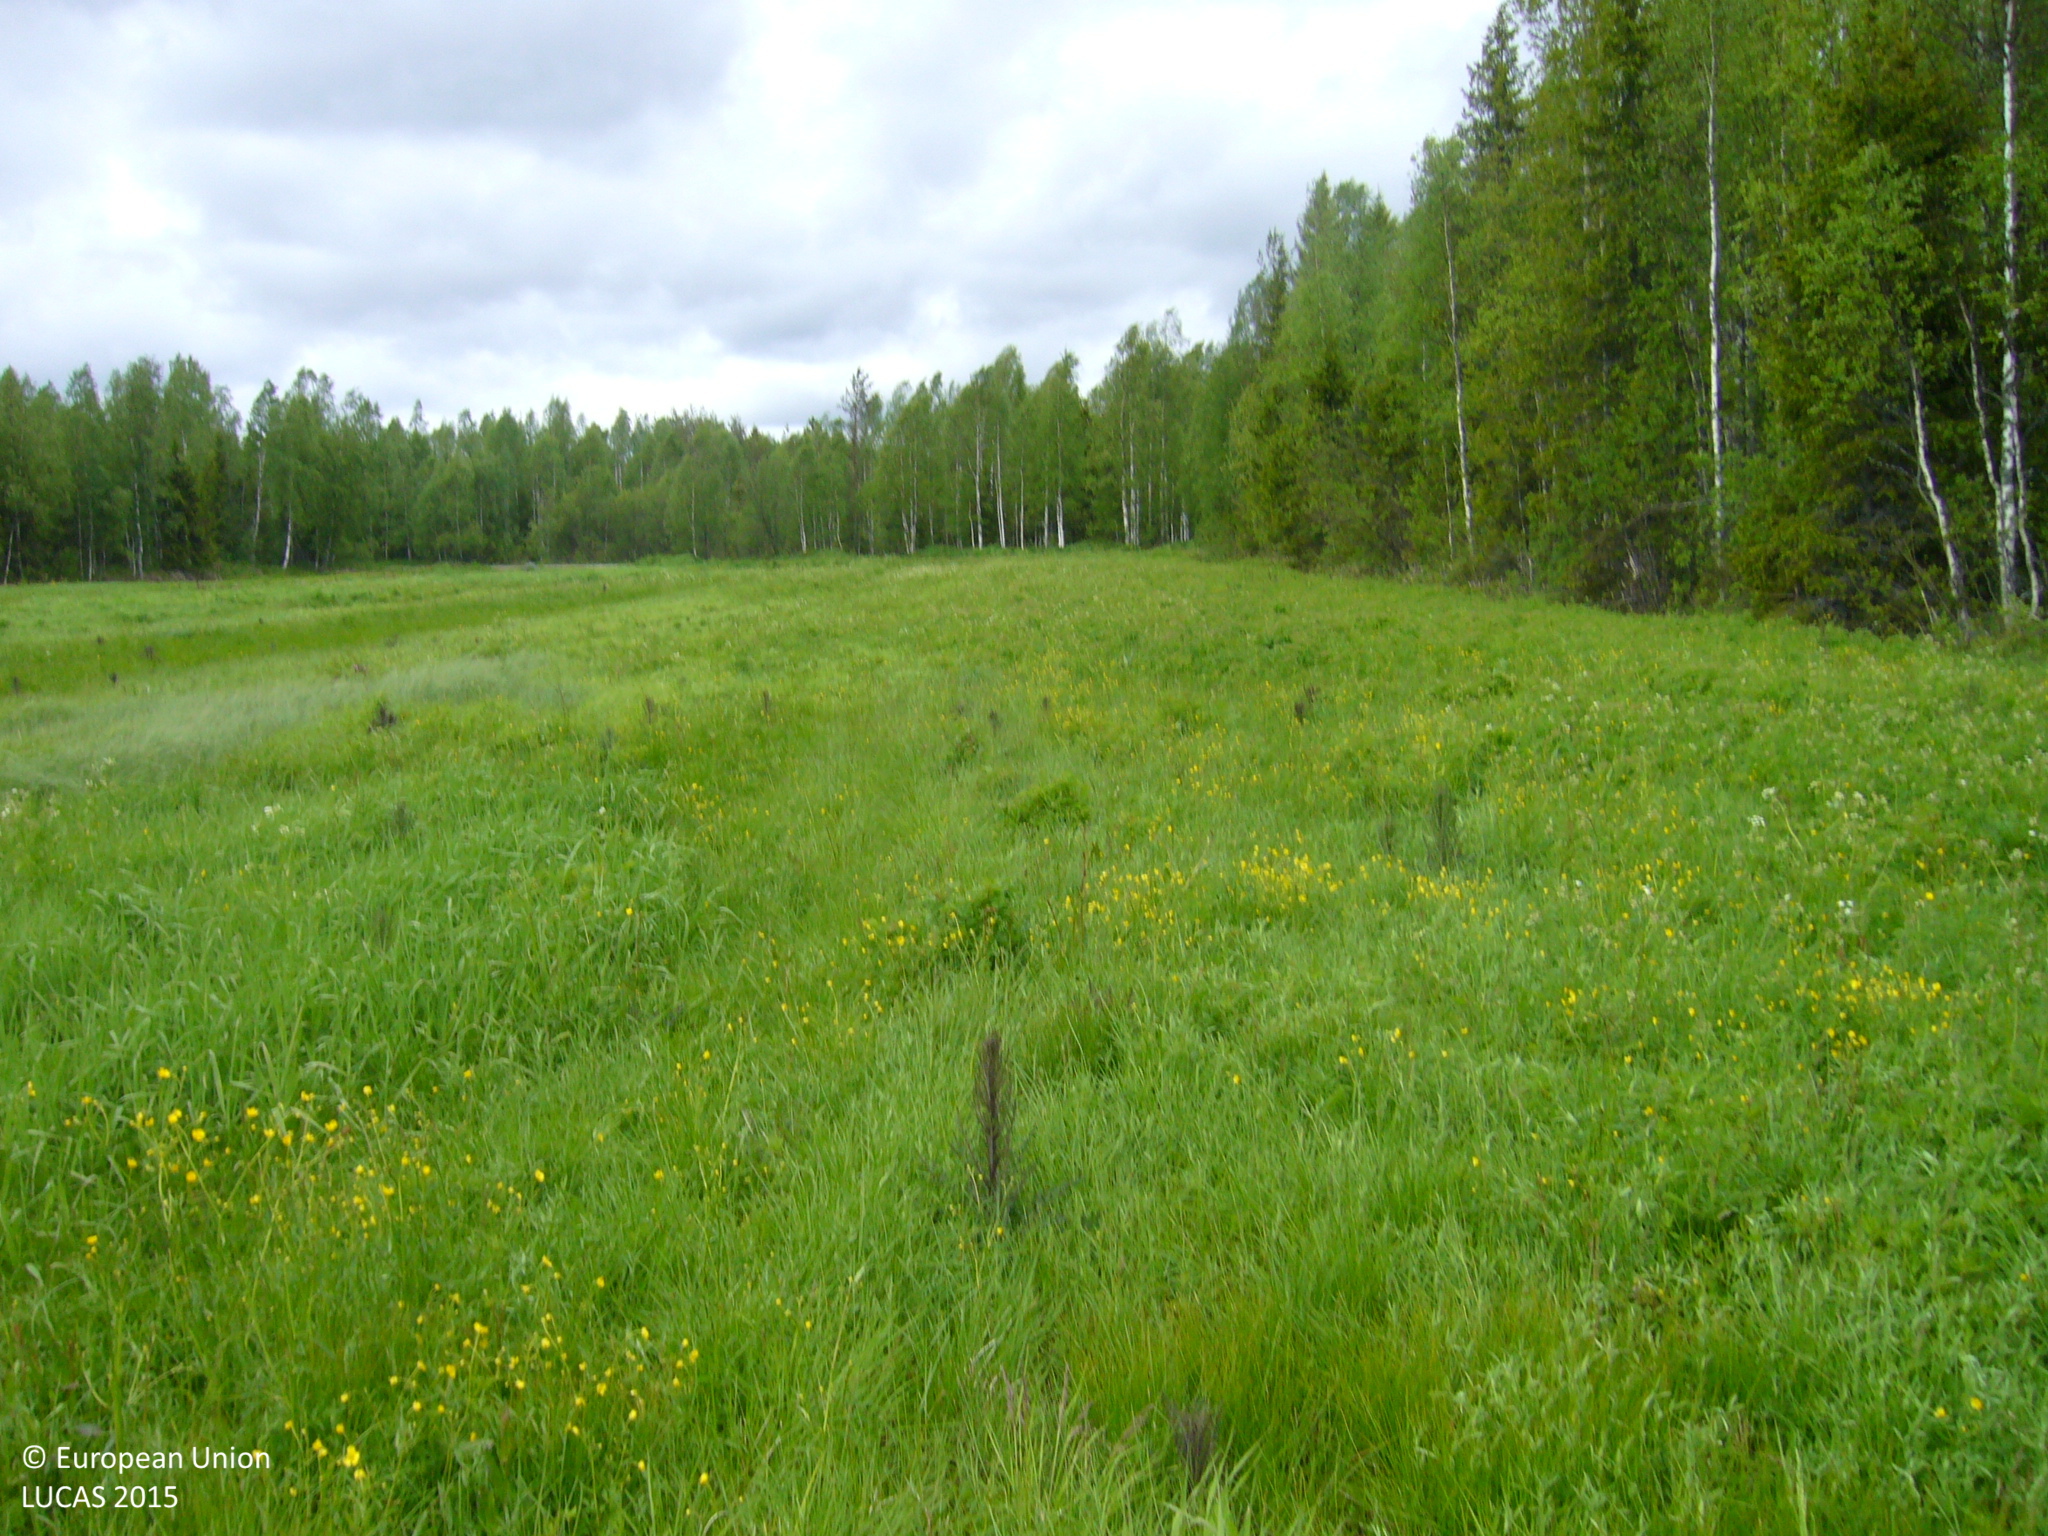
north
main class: Grassland
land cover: Spontaneously vegetated surfaces
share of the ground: > 75 %
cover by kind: herbaceous plants 100 %
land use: Fallow land
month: June
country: FI
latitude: 63.8903
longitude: 27.0621
